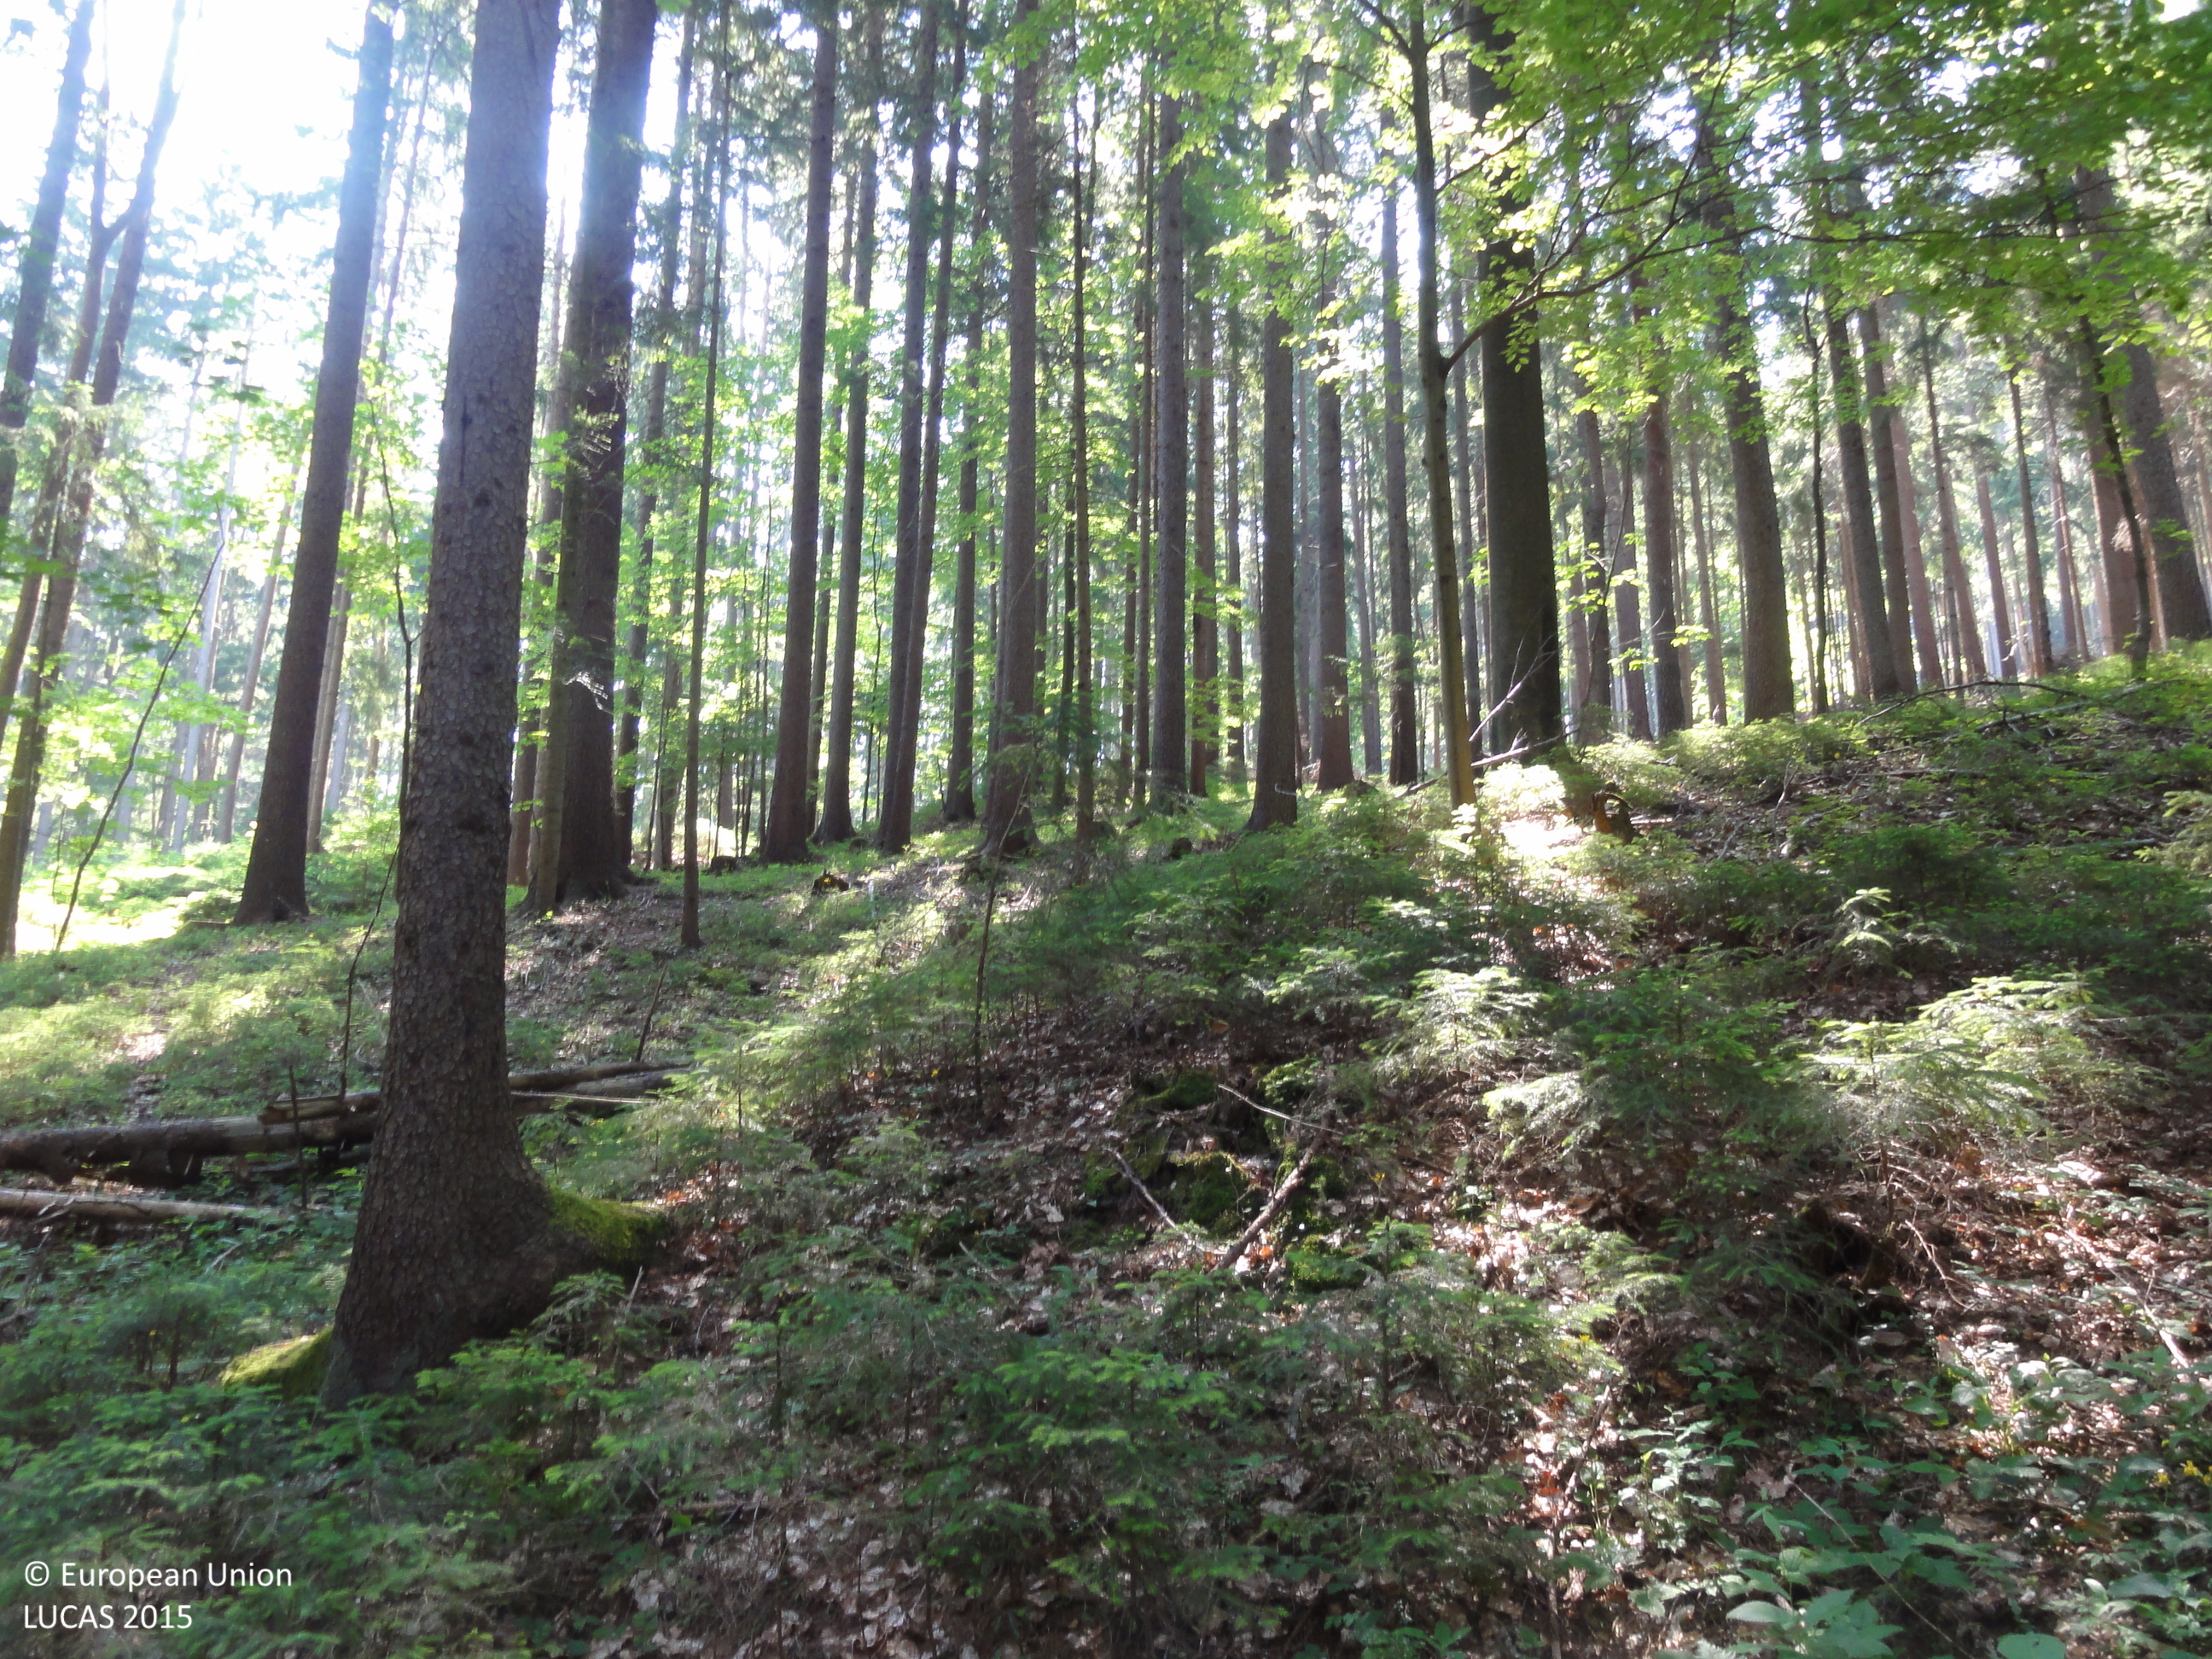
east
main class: Woodland
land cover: Spruce dominated coniferous woodland
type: hemiboreal forest and nemoral coniferous forest and mixed broadleaved-coniferous forest
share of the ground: > 75 %
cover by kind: coniferous forest trees 95 %, broadleaved forest trees 5 %
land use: Forestry
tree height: > 5 m
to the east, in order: Spruce dominated coniferous woodland; Spruce dominated mixed woodland; Tracks; Spruce dominated mixed woodland; Shrubland with sparse tree cover; Spruce dominated coniferous woodland; Spruce dominated mixed woodland; Fences; Grassland with sparse tree/shrub cover; Fences; Spruce dominated mixed woodland
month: June
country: SI
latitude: 46.5271
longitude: 14.9127
